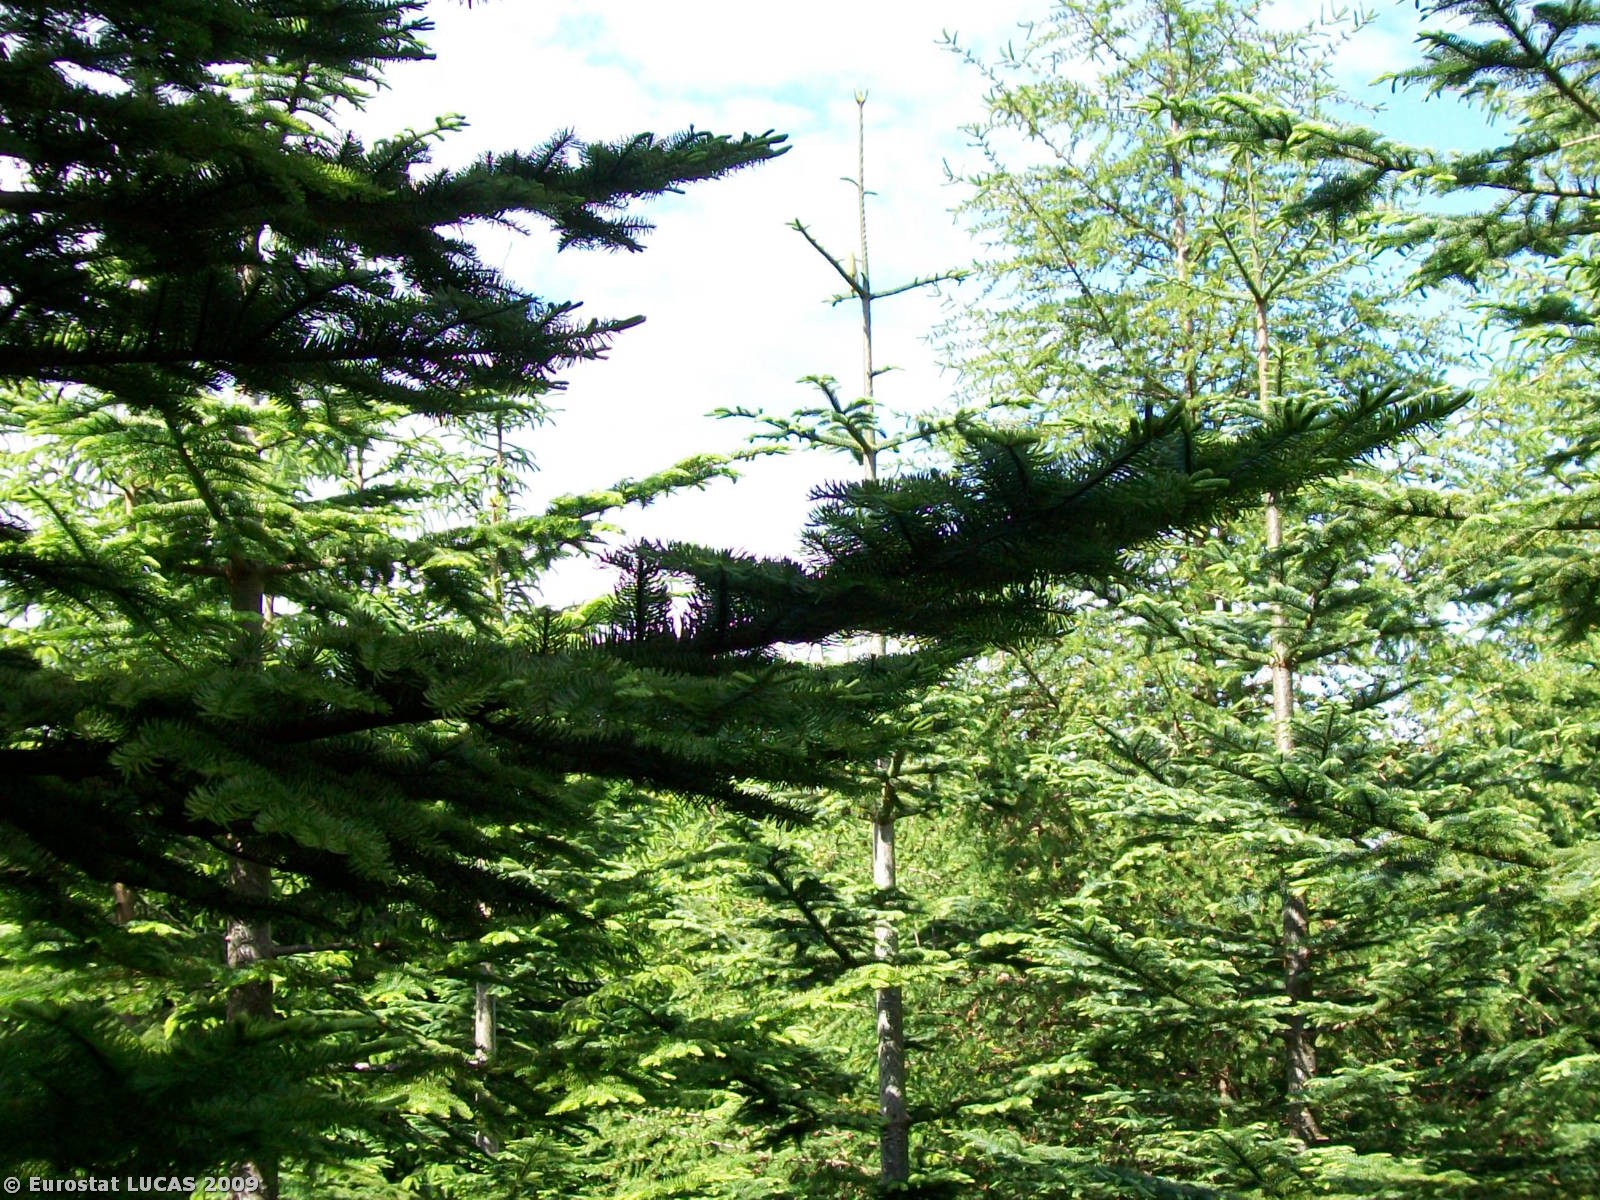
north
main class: Woodland
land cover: Coniferous woodland
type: plantations and self-sown exotic forest
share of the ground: 50 - 75 %
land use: Forestry
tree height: > 5 m
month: June
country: GB
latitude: 56.5048
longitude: -5.3398
